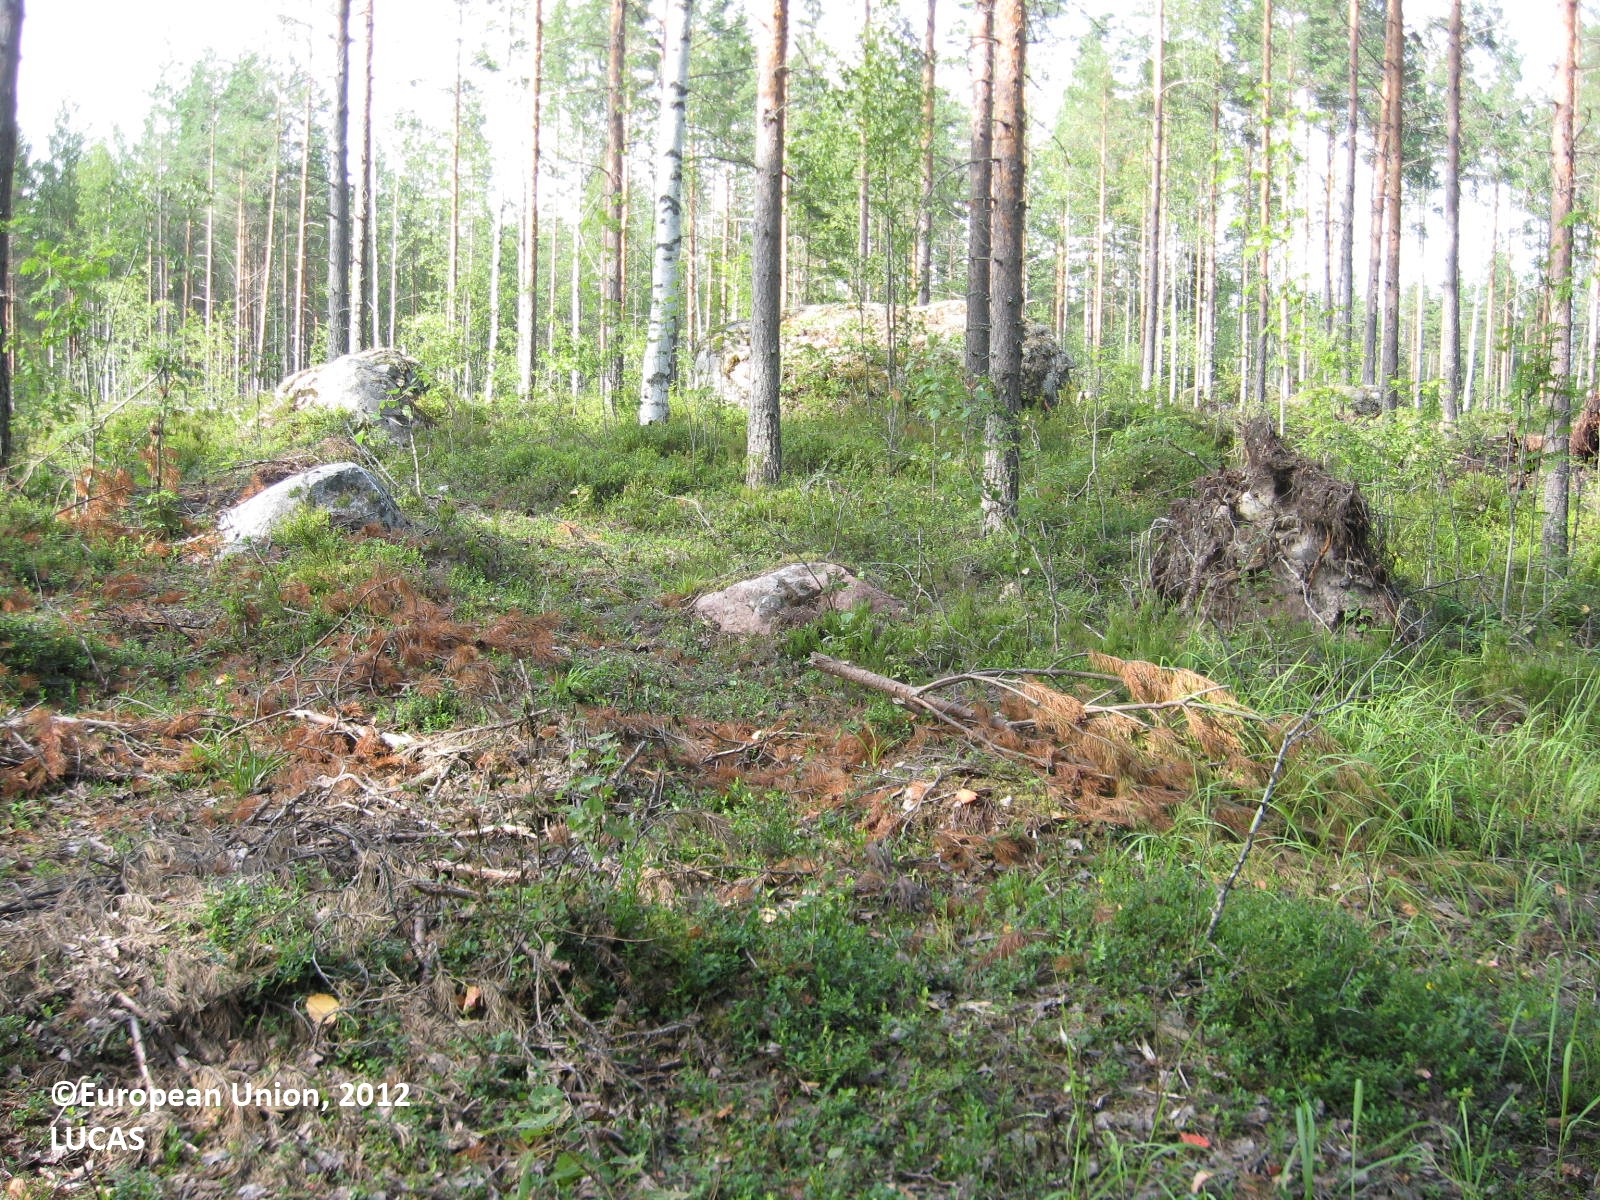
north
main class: Woodland
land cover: Other mixed woodland
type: boreal forest
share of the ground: > 75 %
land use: Forestry
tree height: > 5 m
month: July
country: FI
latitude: 61.9231
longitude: 22.7290
